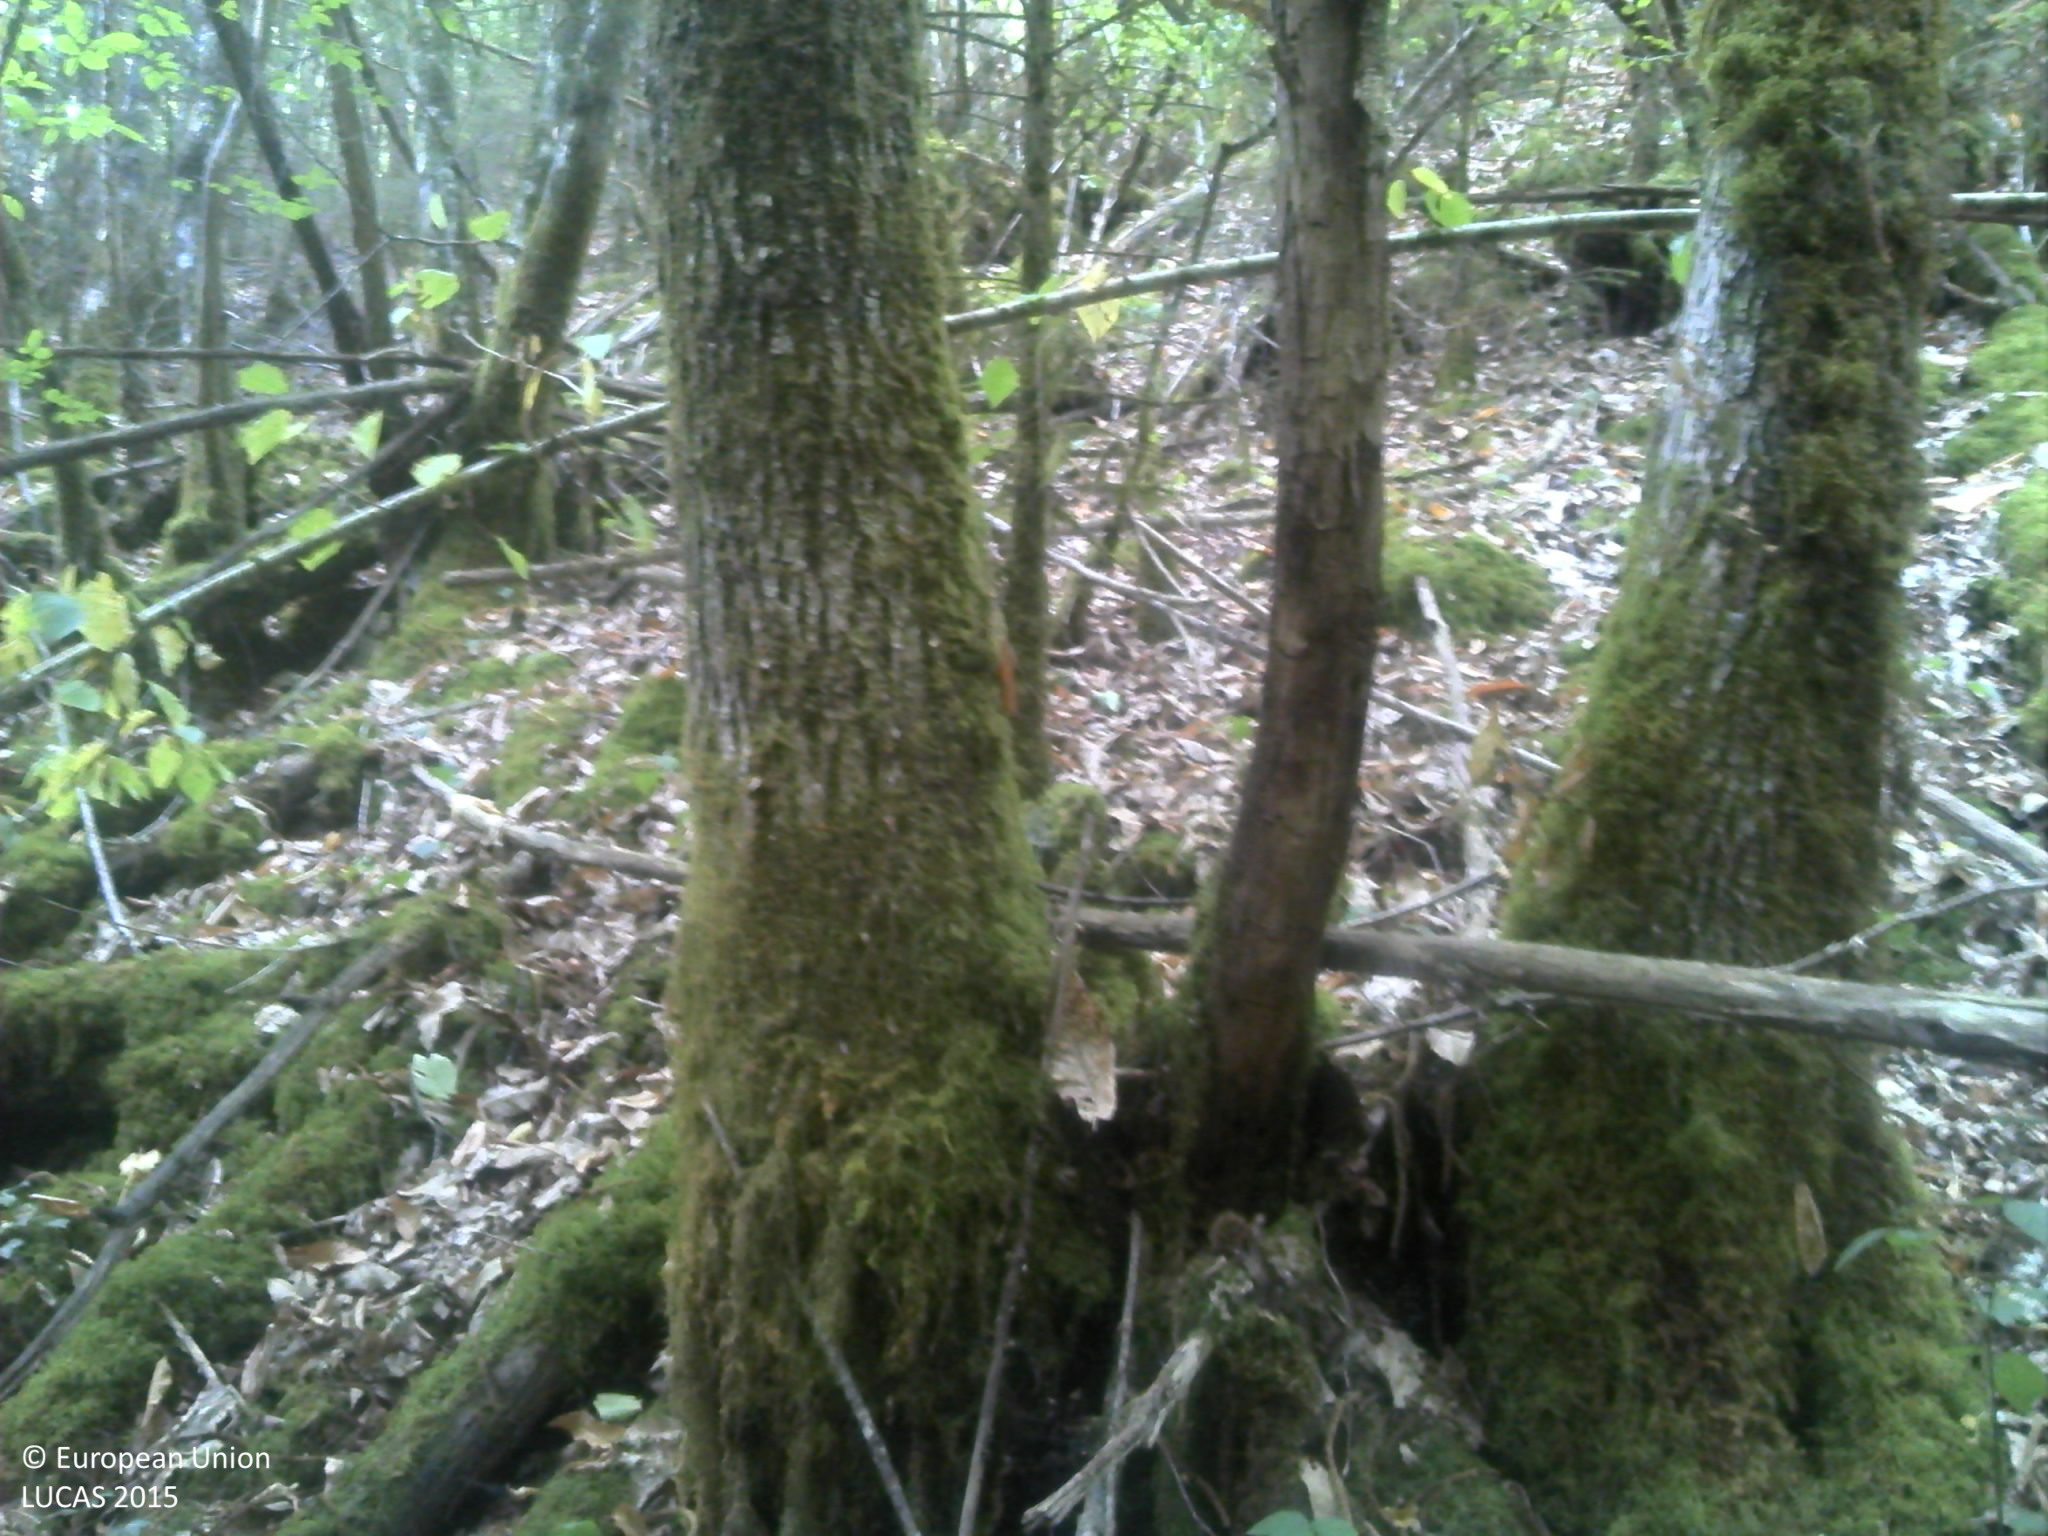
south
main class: Woodland
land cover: Pine dominated mixed woodland
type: mountainous beech forest
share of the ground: > 75 %
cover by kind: broadleaved forest trees 40 %, coniferous forest trees 35 %, lichens and mosses 20 %, herbaceous plants 5 %
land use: Forestry
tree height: > 5 m
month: July
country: FR
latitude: 45.1880
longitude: 1.8384
